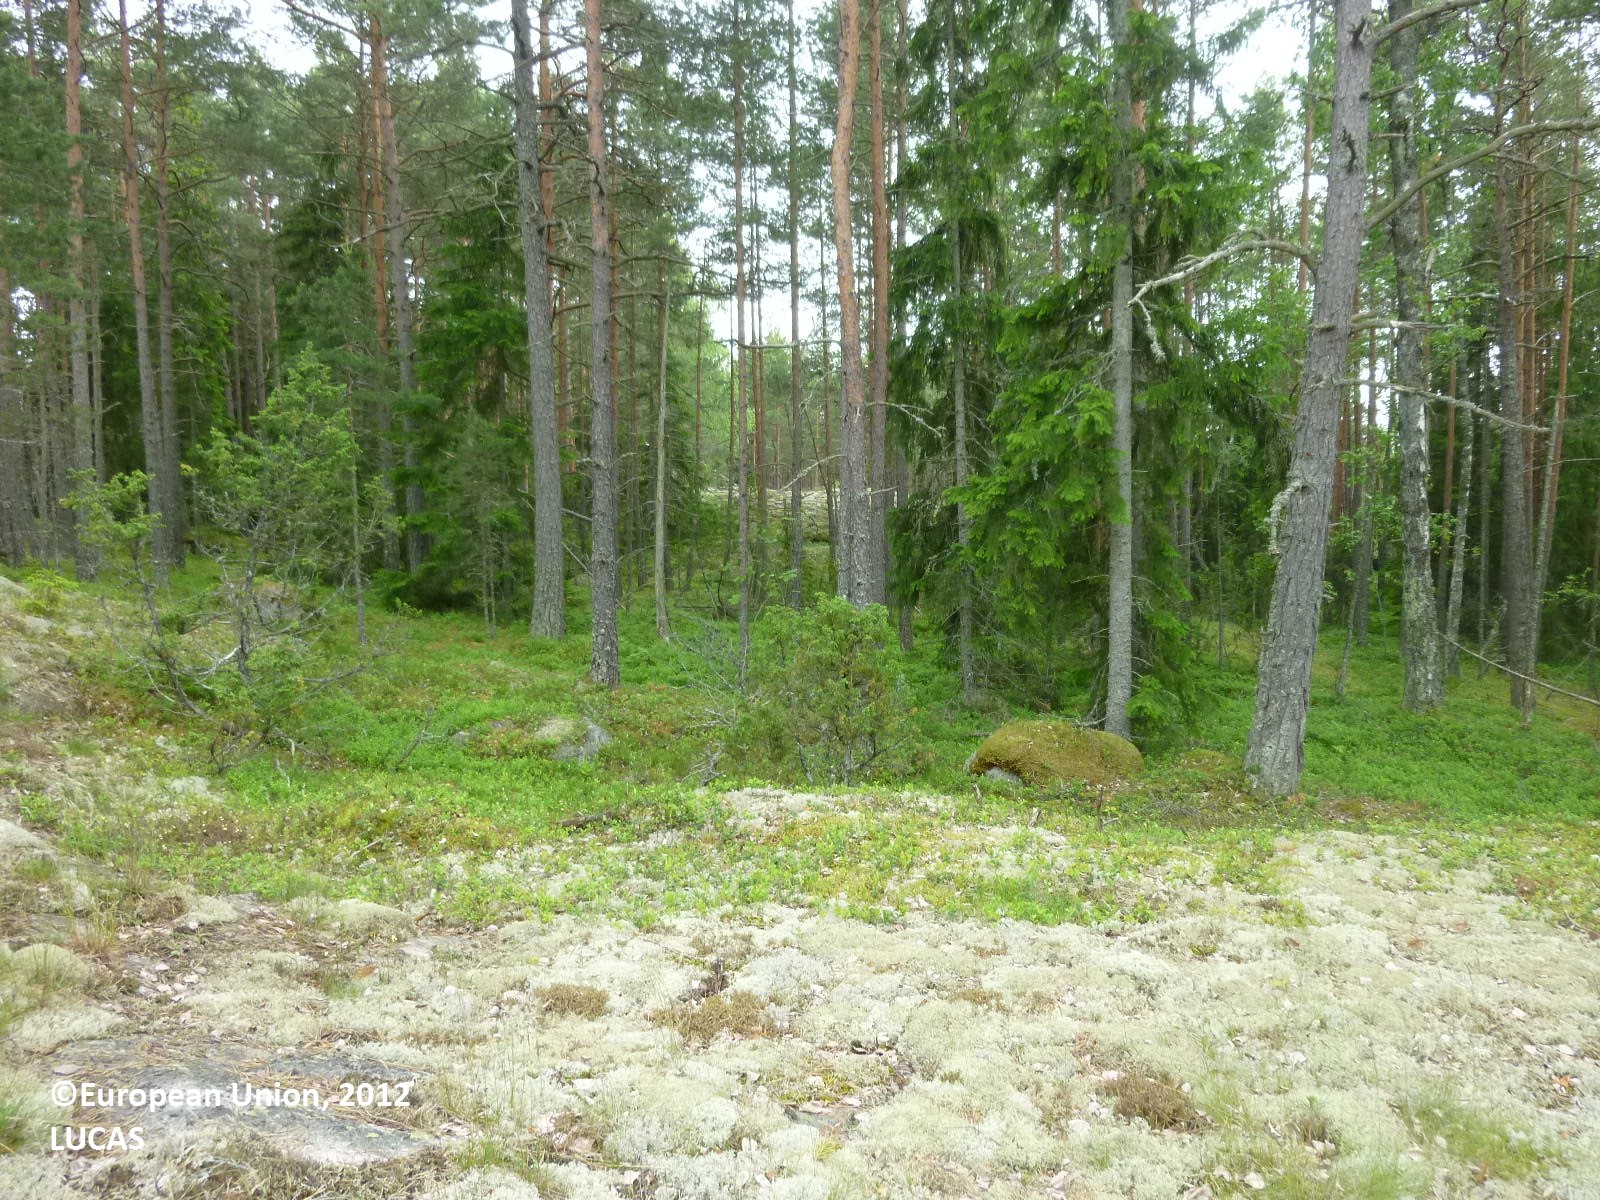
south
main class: Woodland
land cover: Pine dominated coniferous woodland
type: boreal forest
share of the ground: 10 - 25 %
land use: Forestry
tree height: > 5 m
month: June
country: FI
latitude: 60.2798
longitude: 22.4946
